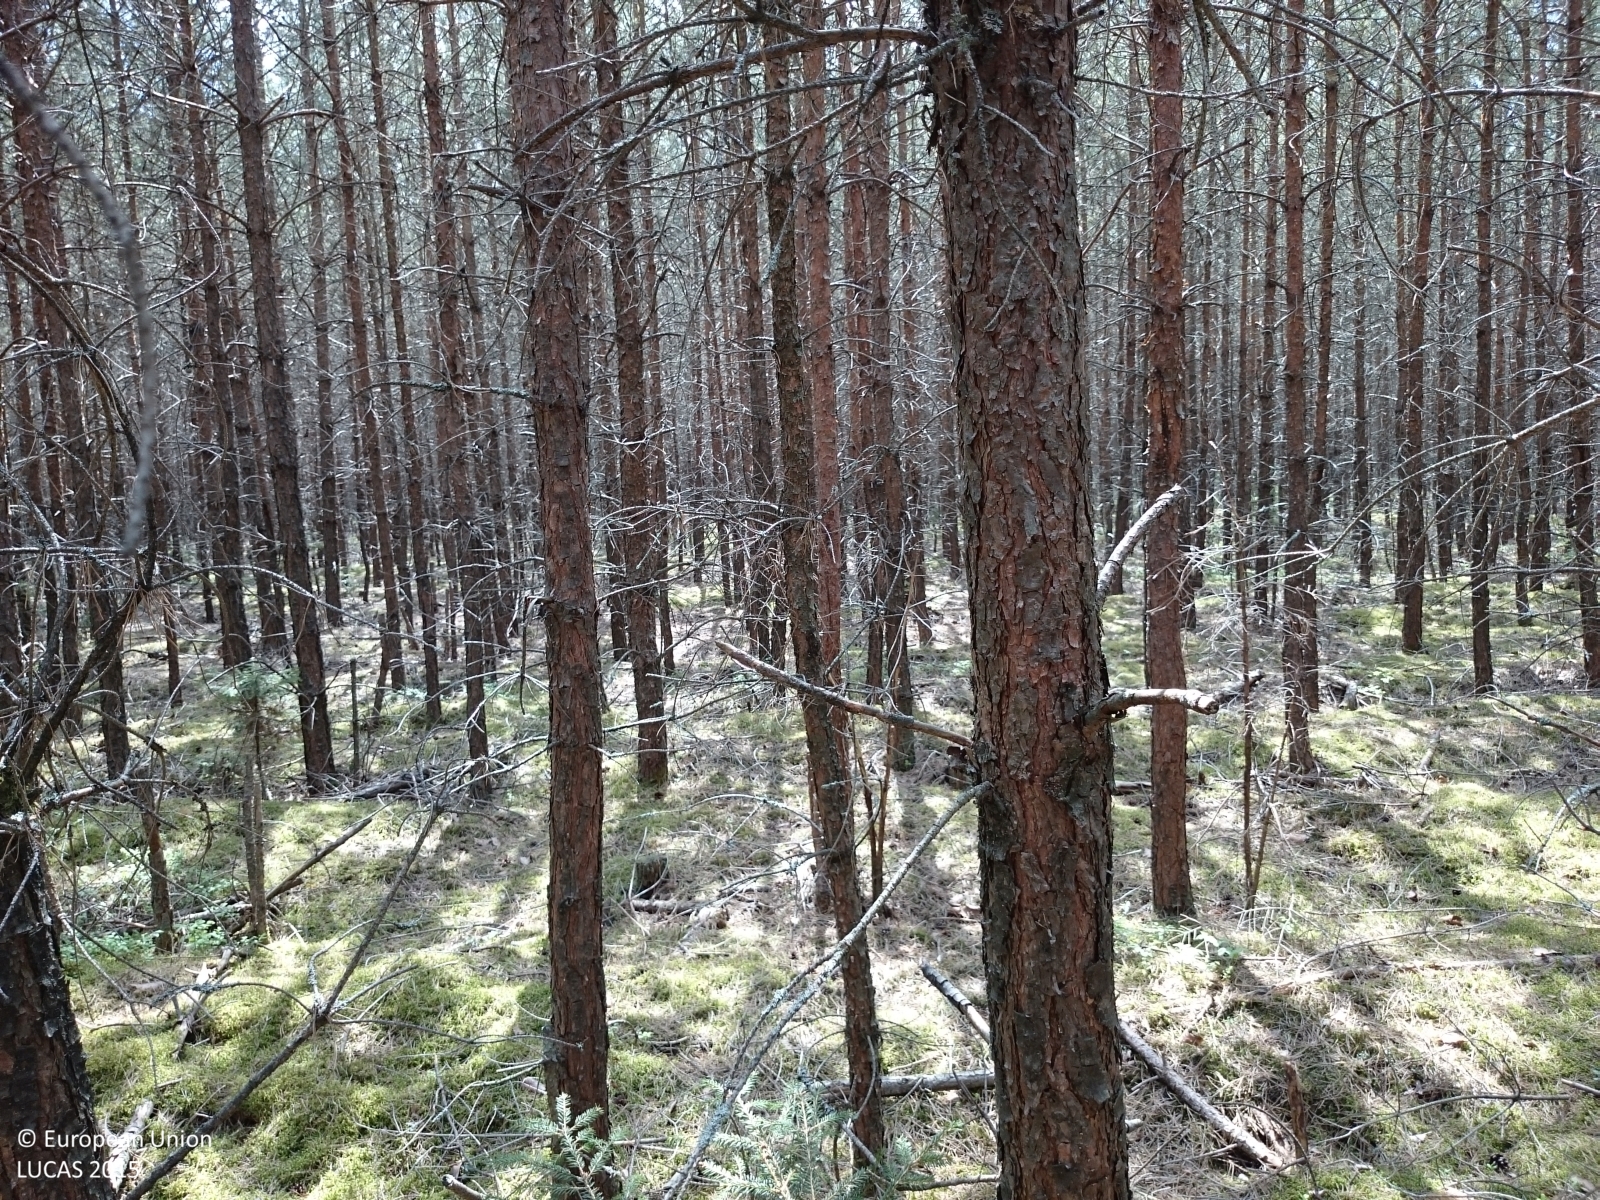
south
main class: Woodland
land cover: Pine dominated coniferous woodland
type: hemiboreal forest and nemoral coniferous forest and mixed broadleaved-coniferous forest
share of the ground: > 75 %
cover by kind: coniferous forest trees 90 %, herbaceous plants 5 %, lichens and mosses 5 %
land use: Forestry
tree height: > 5 m
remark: Nursery
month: May
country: PL
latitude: 52.7303
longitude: 16.0028
